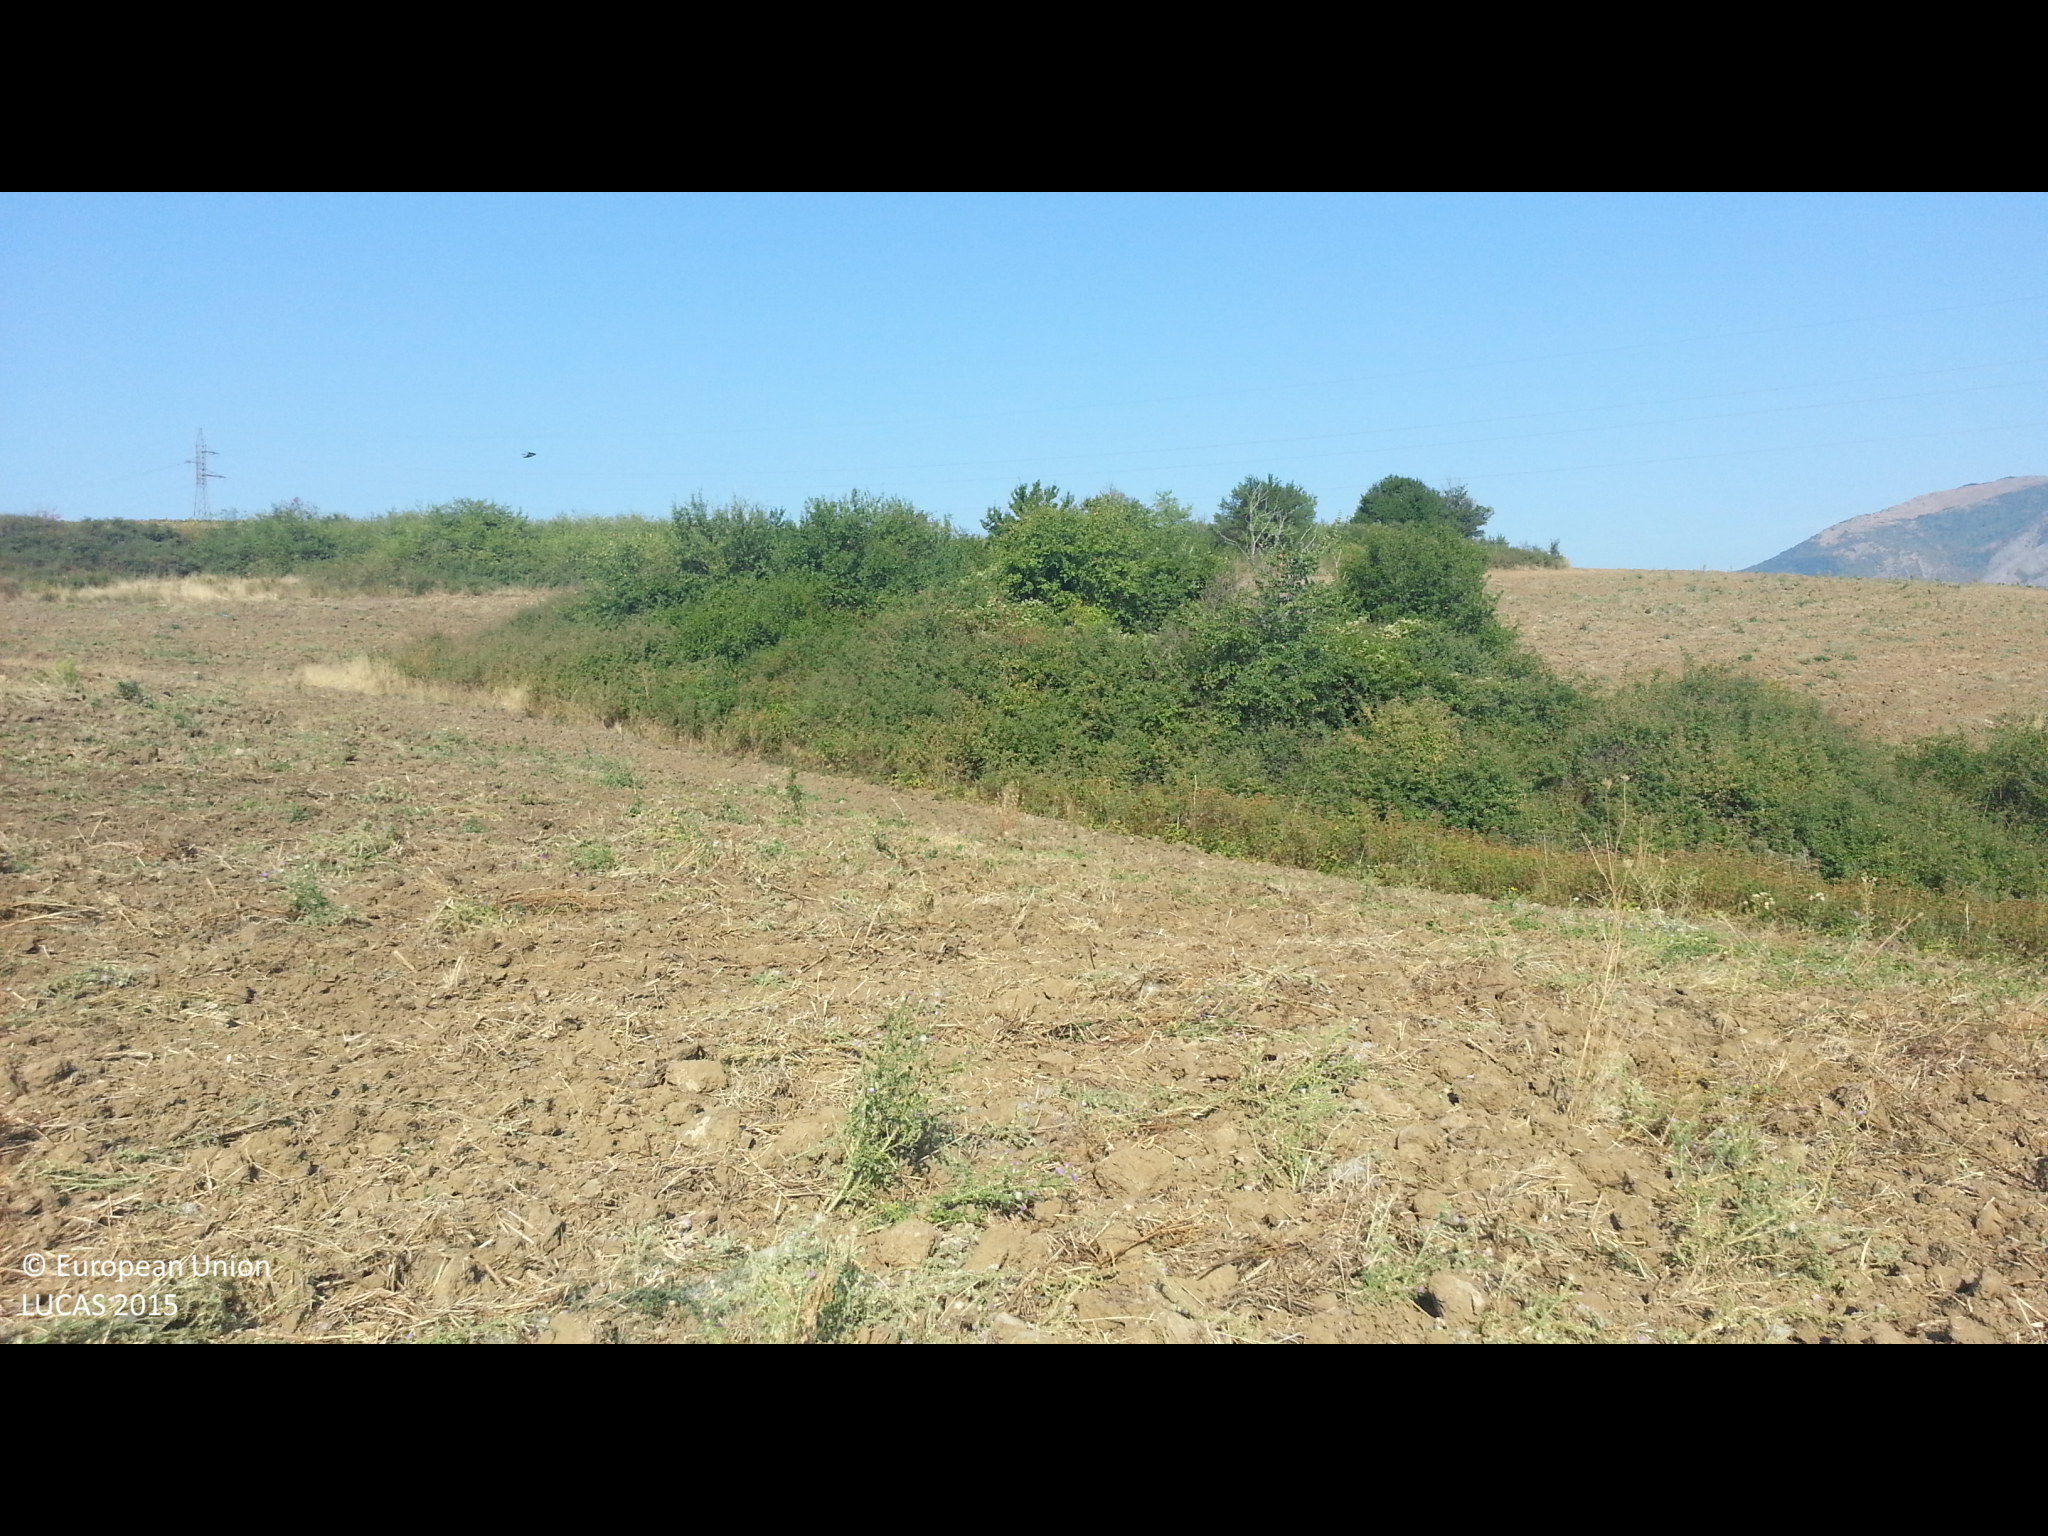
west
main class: Cropland
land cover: Common wheat
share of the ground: < 10 %
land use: Agriculture (excluding fallow land and kitchen gardens)
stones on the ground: 10 - 25 %
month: September
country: BG
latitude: 42.3449
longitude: 22.9779
